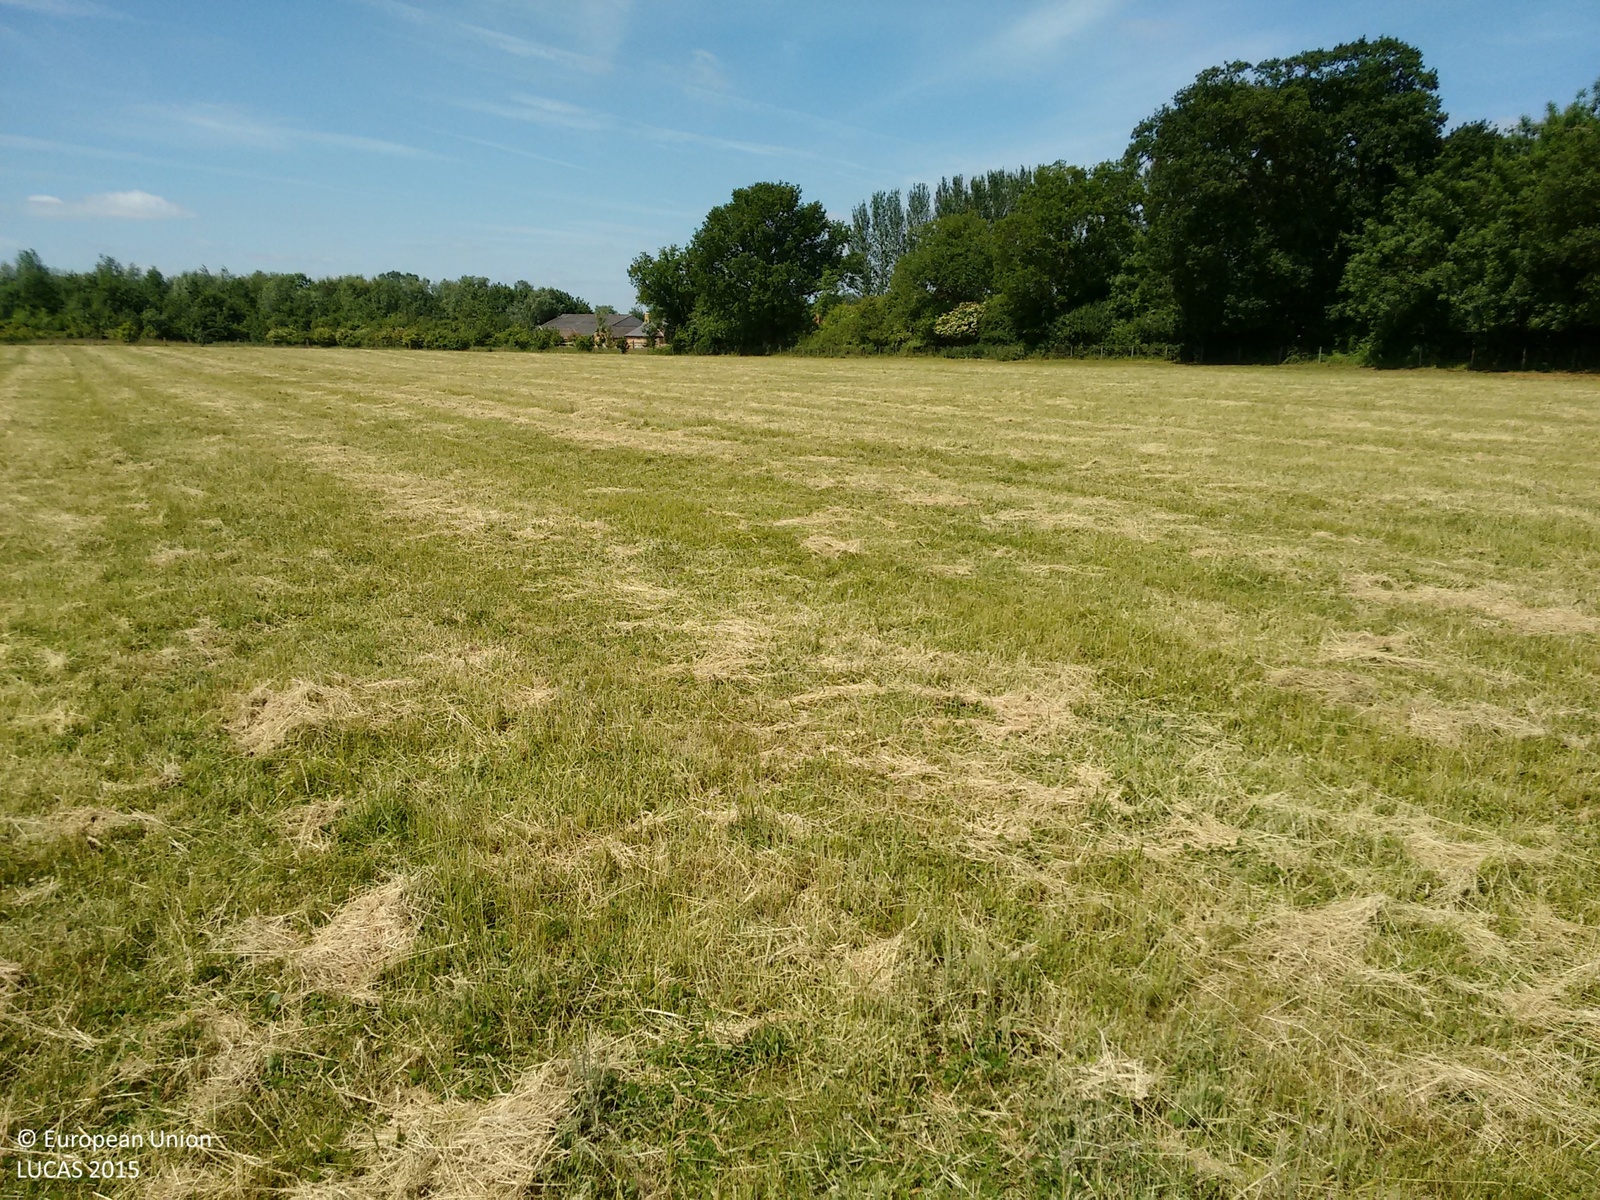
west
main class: Grassland
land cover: Grassland without tree/shrub cover
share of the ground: > 75 %
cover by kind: herbaceous plants 100 %
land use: Agriculture (excluding fallow land and kitchen gardens)
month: June
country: GB
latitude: 51.8679
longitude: -1.1566
